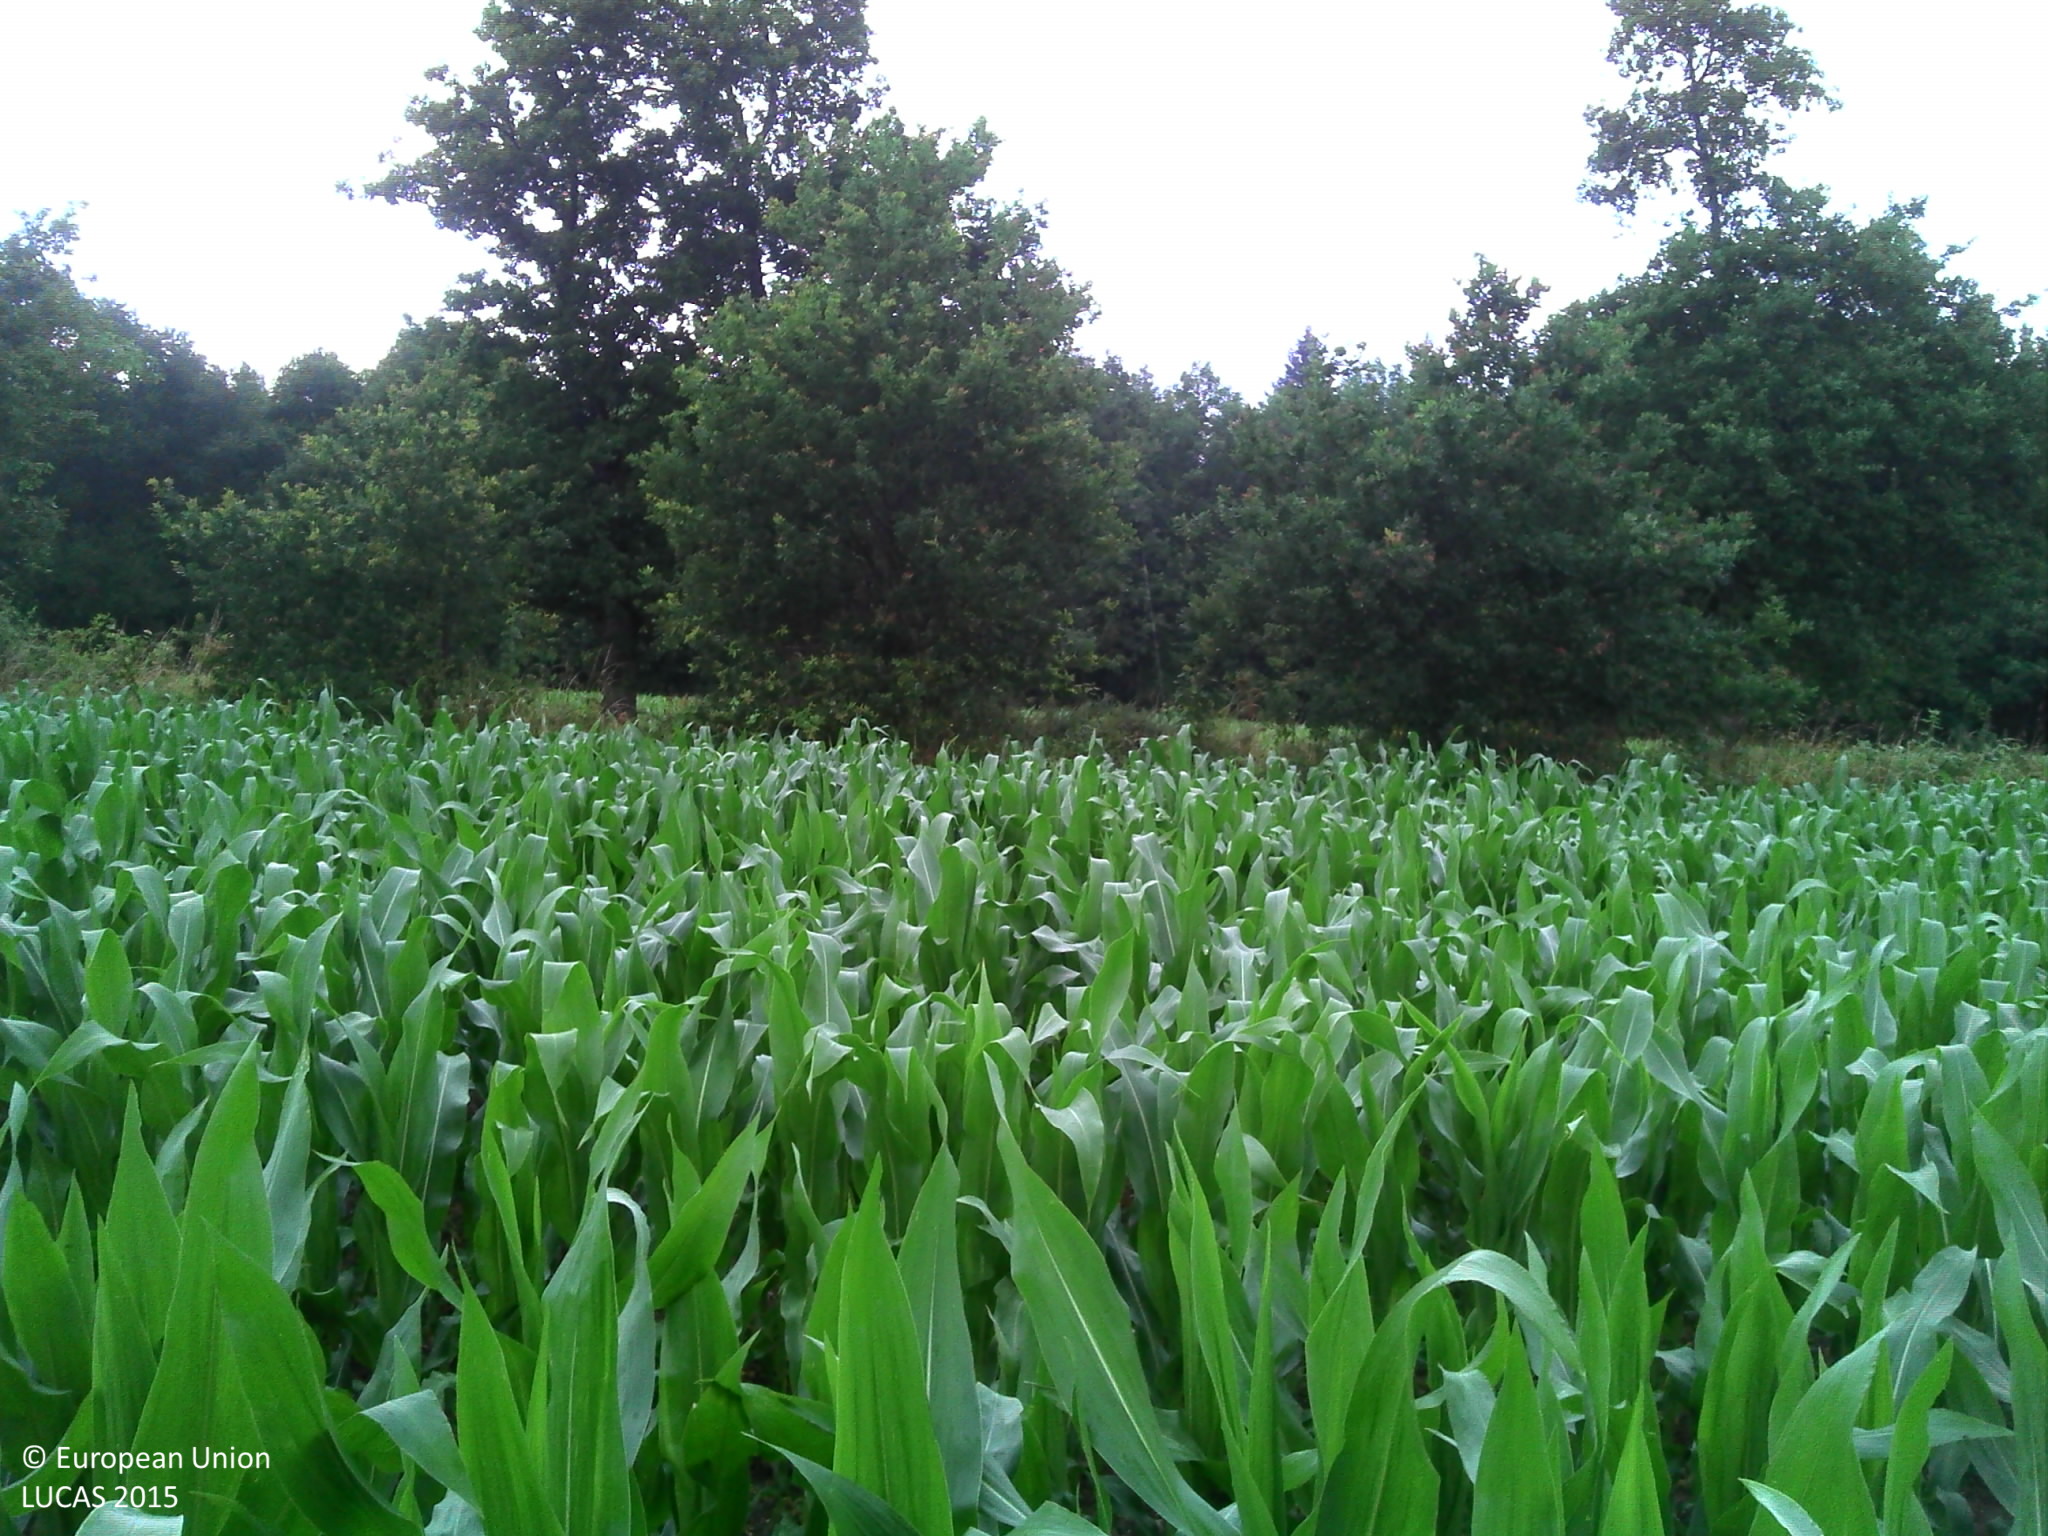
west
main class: Cropland
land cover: Maize
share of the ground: > 75 %
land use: Agriculture (excluding fallow land and kitchen gardens)
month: July
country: FR
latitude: 47.9025
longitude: -1.4009
